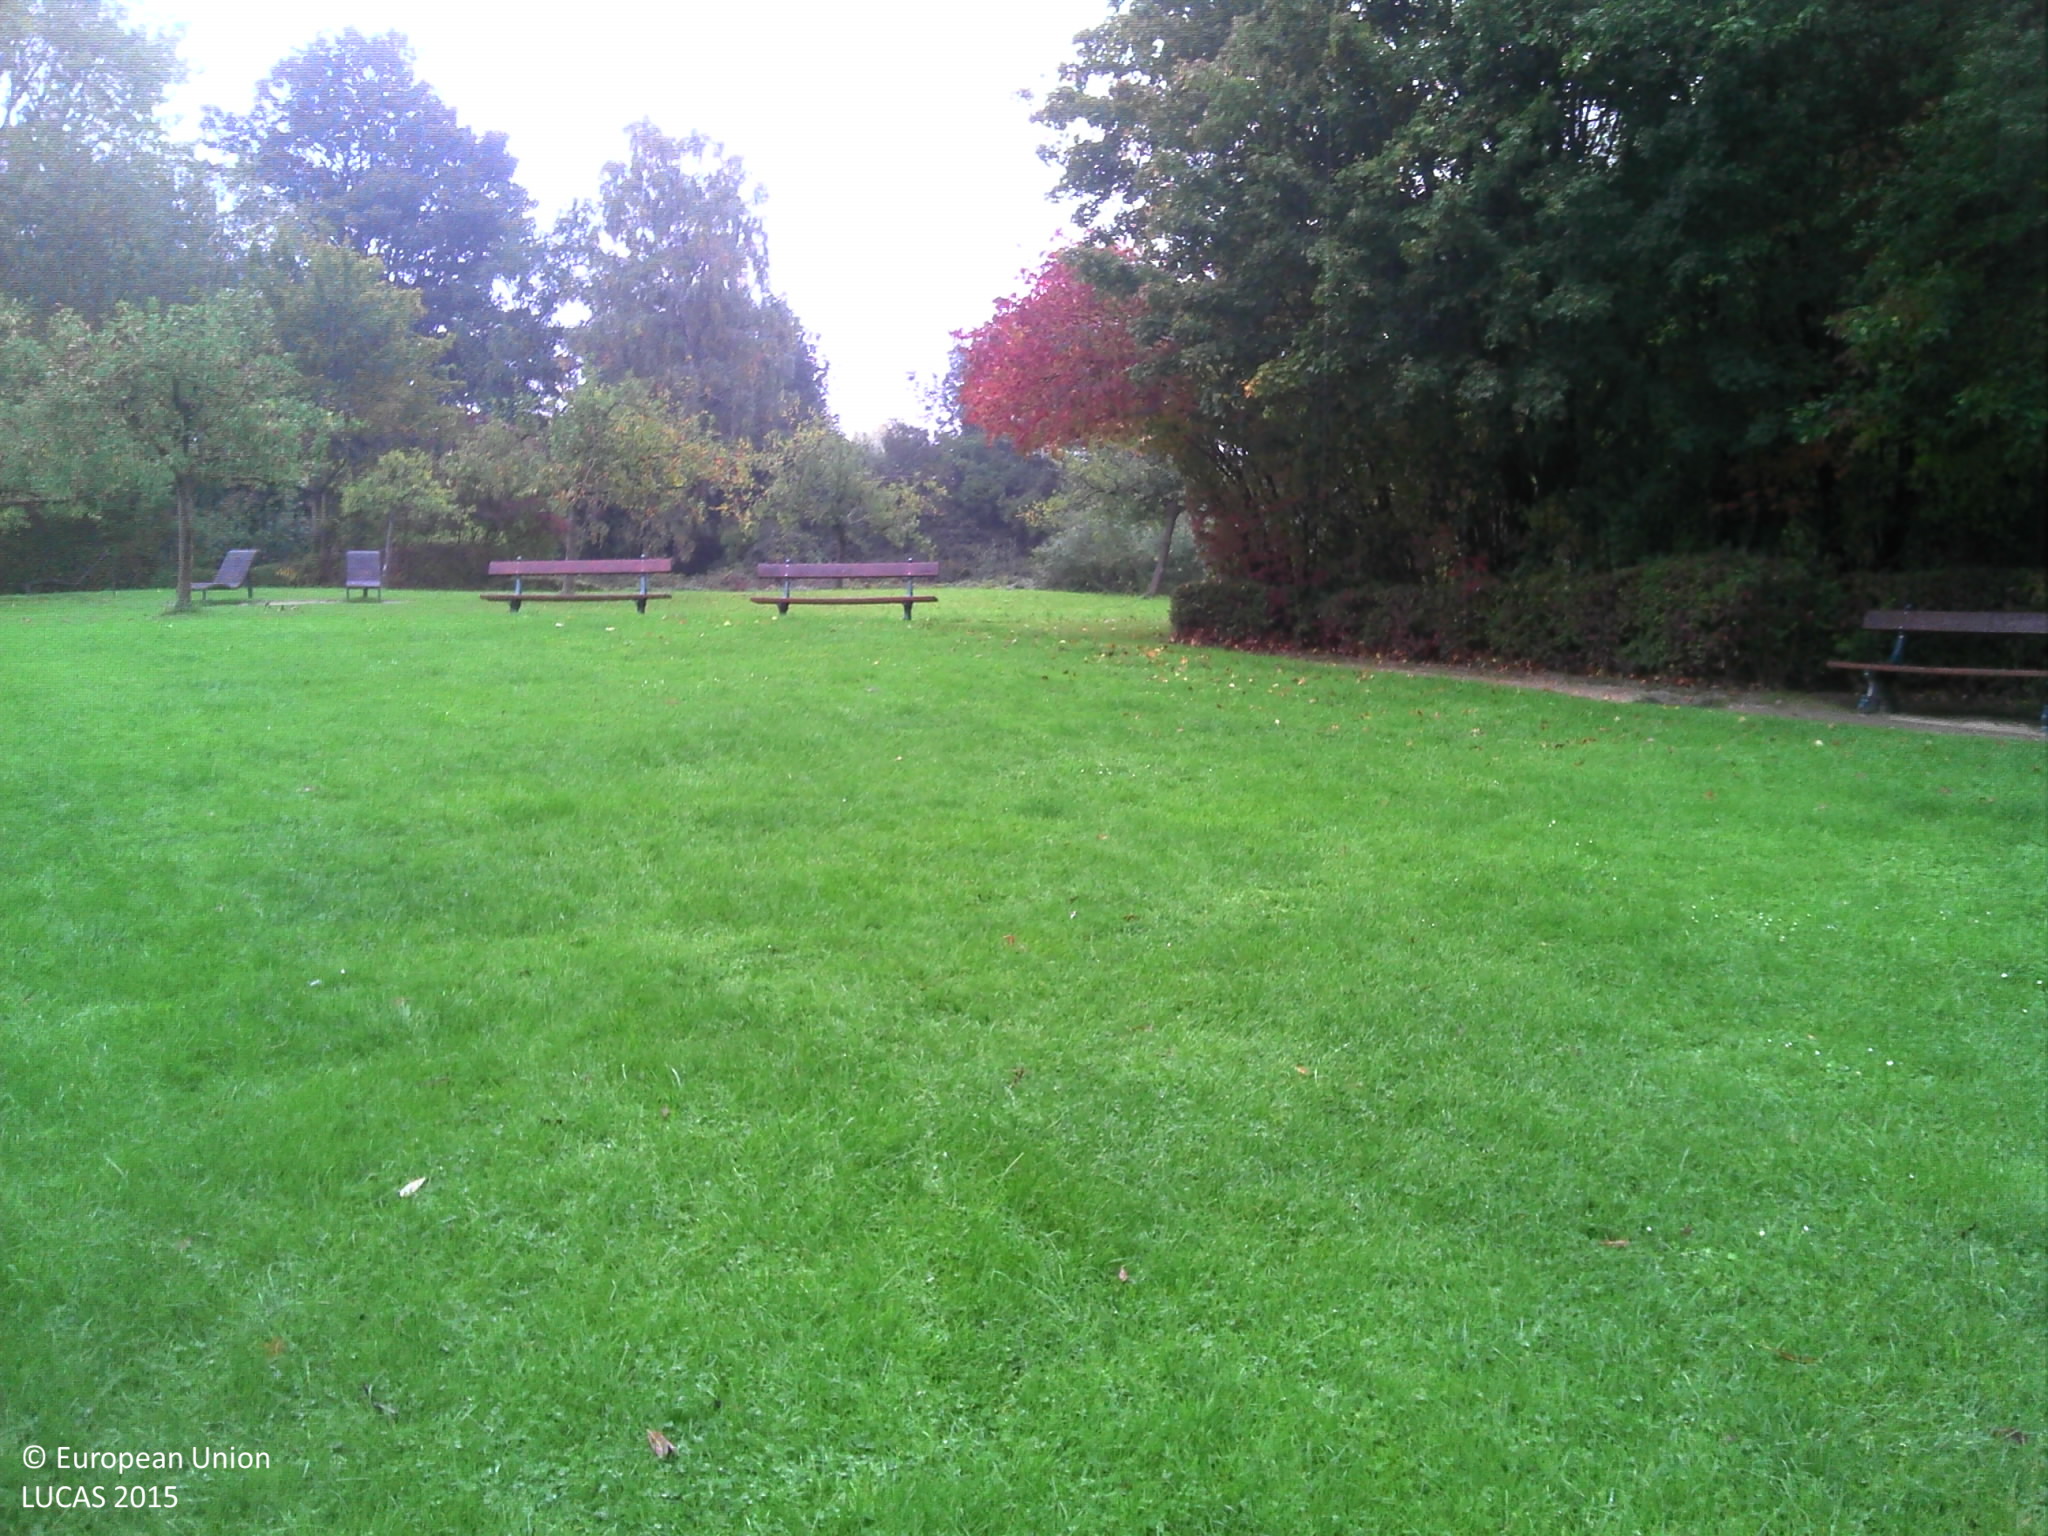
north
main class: Grassland
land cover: Grassland without tree/shrub cover
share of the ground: > 75 %
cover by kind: herbaceous plants 100 %
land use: Amenities, museums, leisure
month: October
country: BE
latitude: 50.8528
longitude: 4.2991
